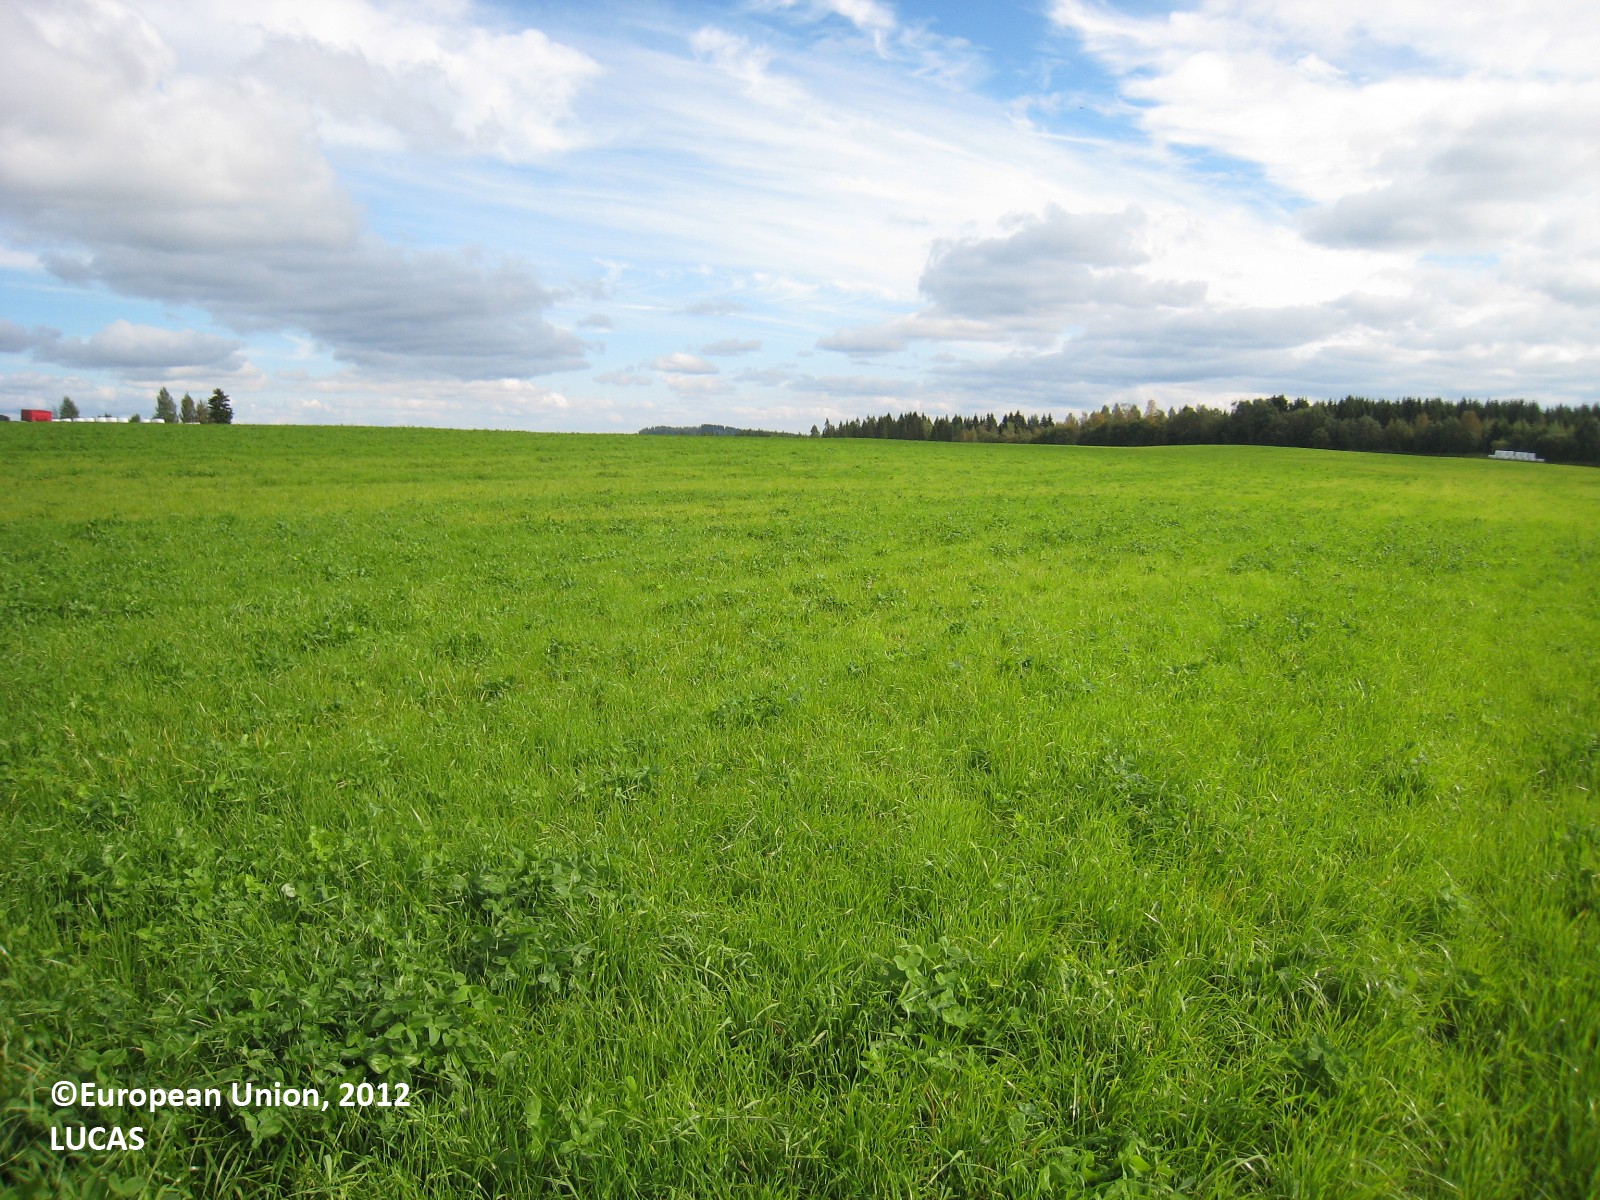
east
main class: Cropland
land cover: Temporary grasslands
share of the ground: > 75 %
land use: Agriculture (excluding fallow land and kitchen gardens)
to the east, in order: Temporary grasslands
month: August
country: FI
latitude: 62.2111
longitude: 27.2951
